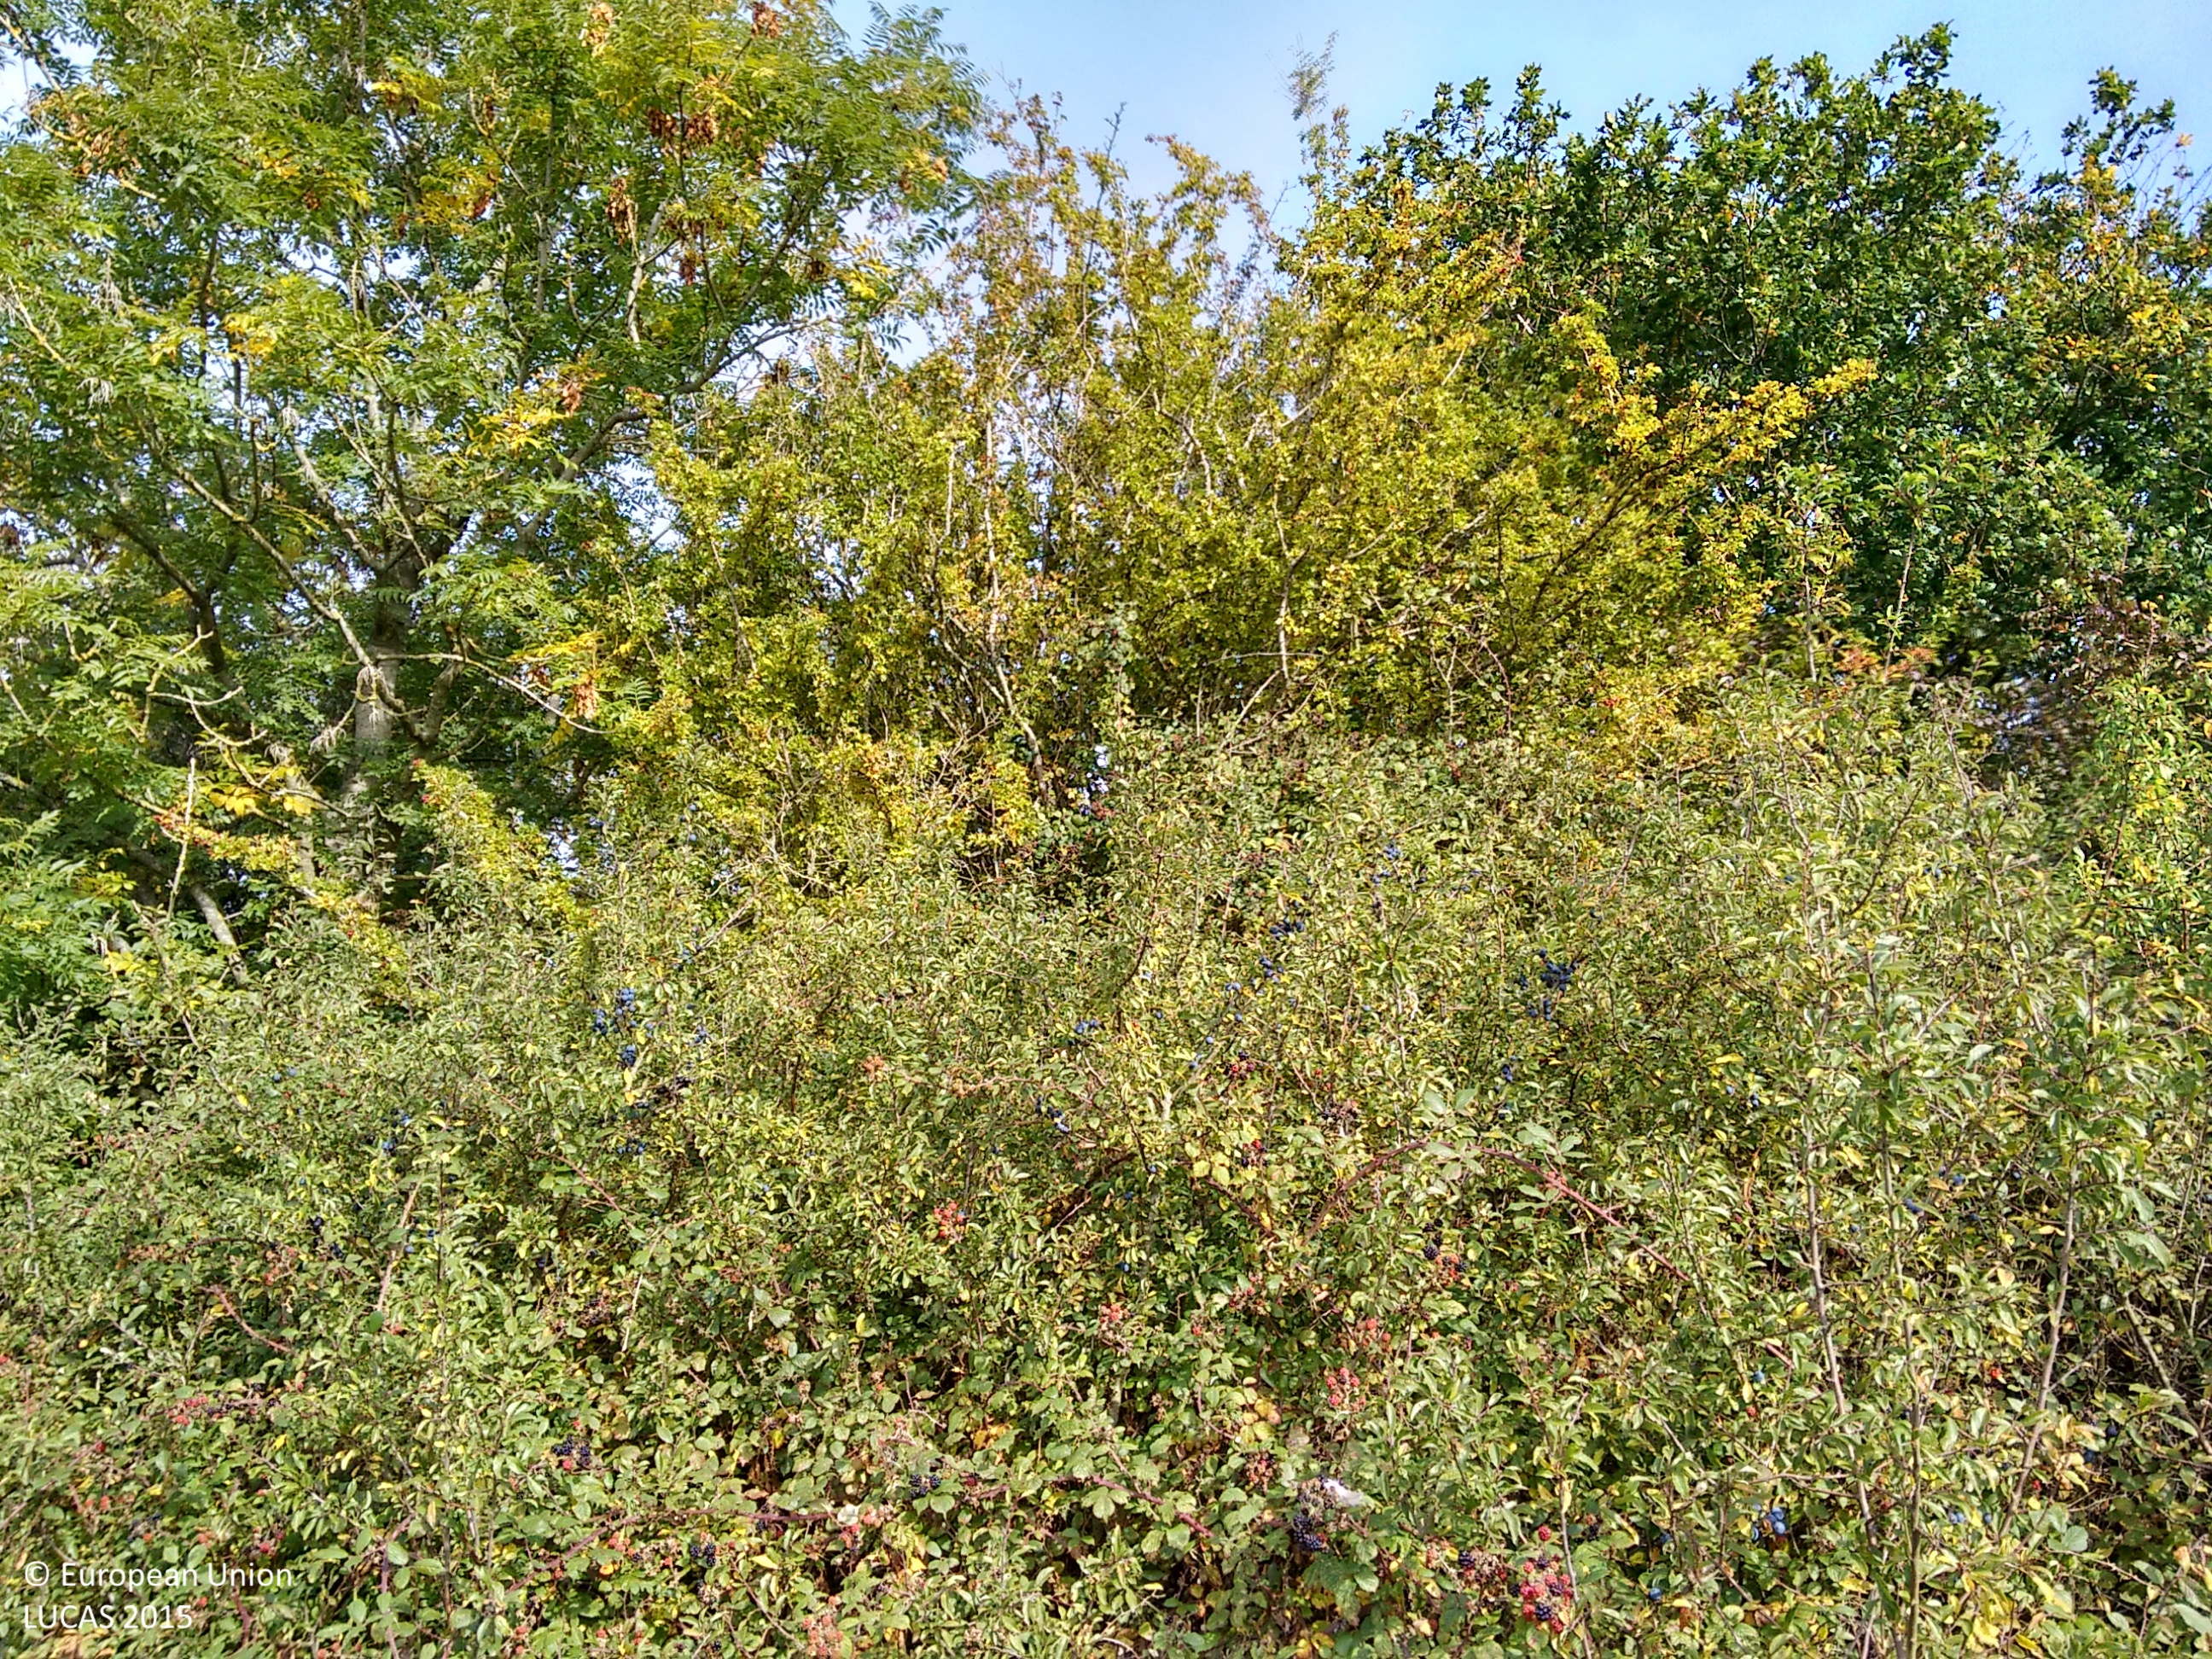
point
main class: Woodland
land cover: Broadleaved woodland
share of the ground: > 75 %
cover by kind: broadleaved forest trees 60 %, shrubs 40 %
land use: Agriculture (excluding fallow land and kitchen gardens)
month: September
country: GB
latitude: 51.6021
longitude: -2.3506
